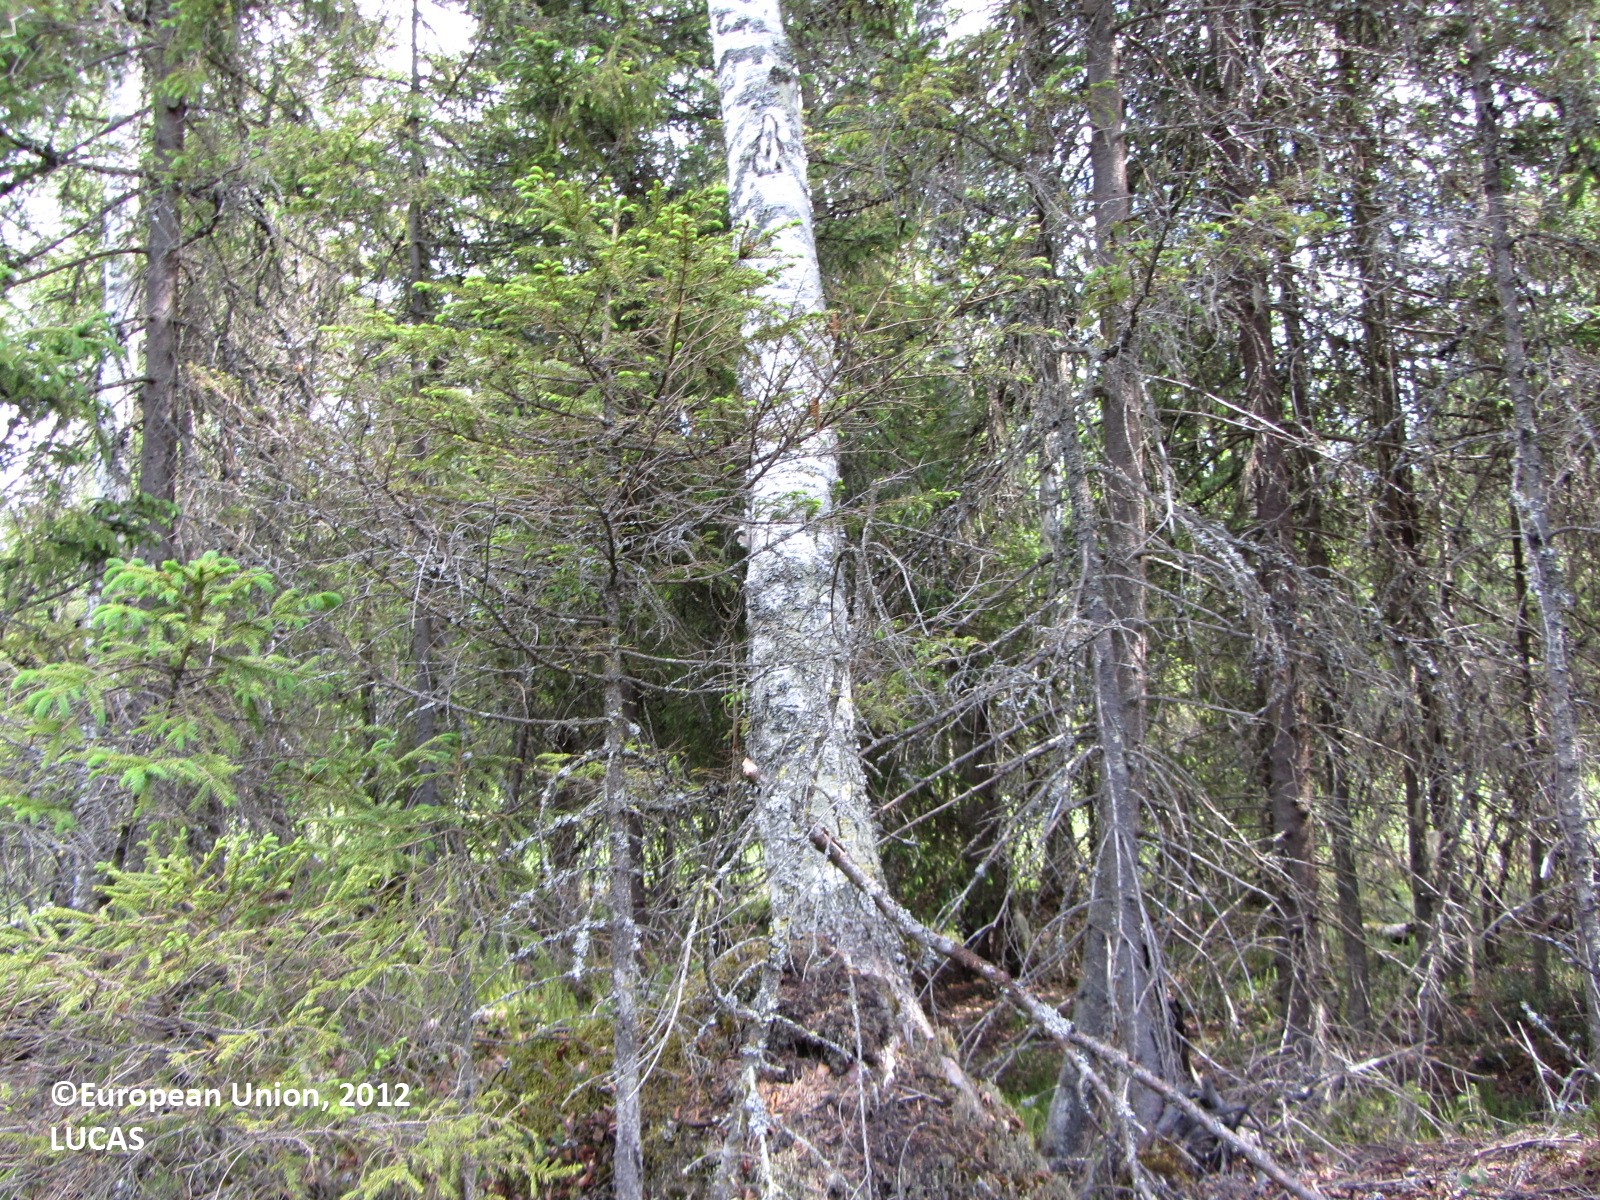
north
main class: Woodland
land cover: Broadleaved woodland
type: boreal forest
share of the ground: > 75 %
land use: Forestry
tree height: > 5 m
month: June
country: FI
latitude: 62.1533
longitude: 24.7793
